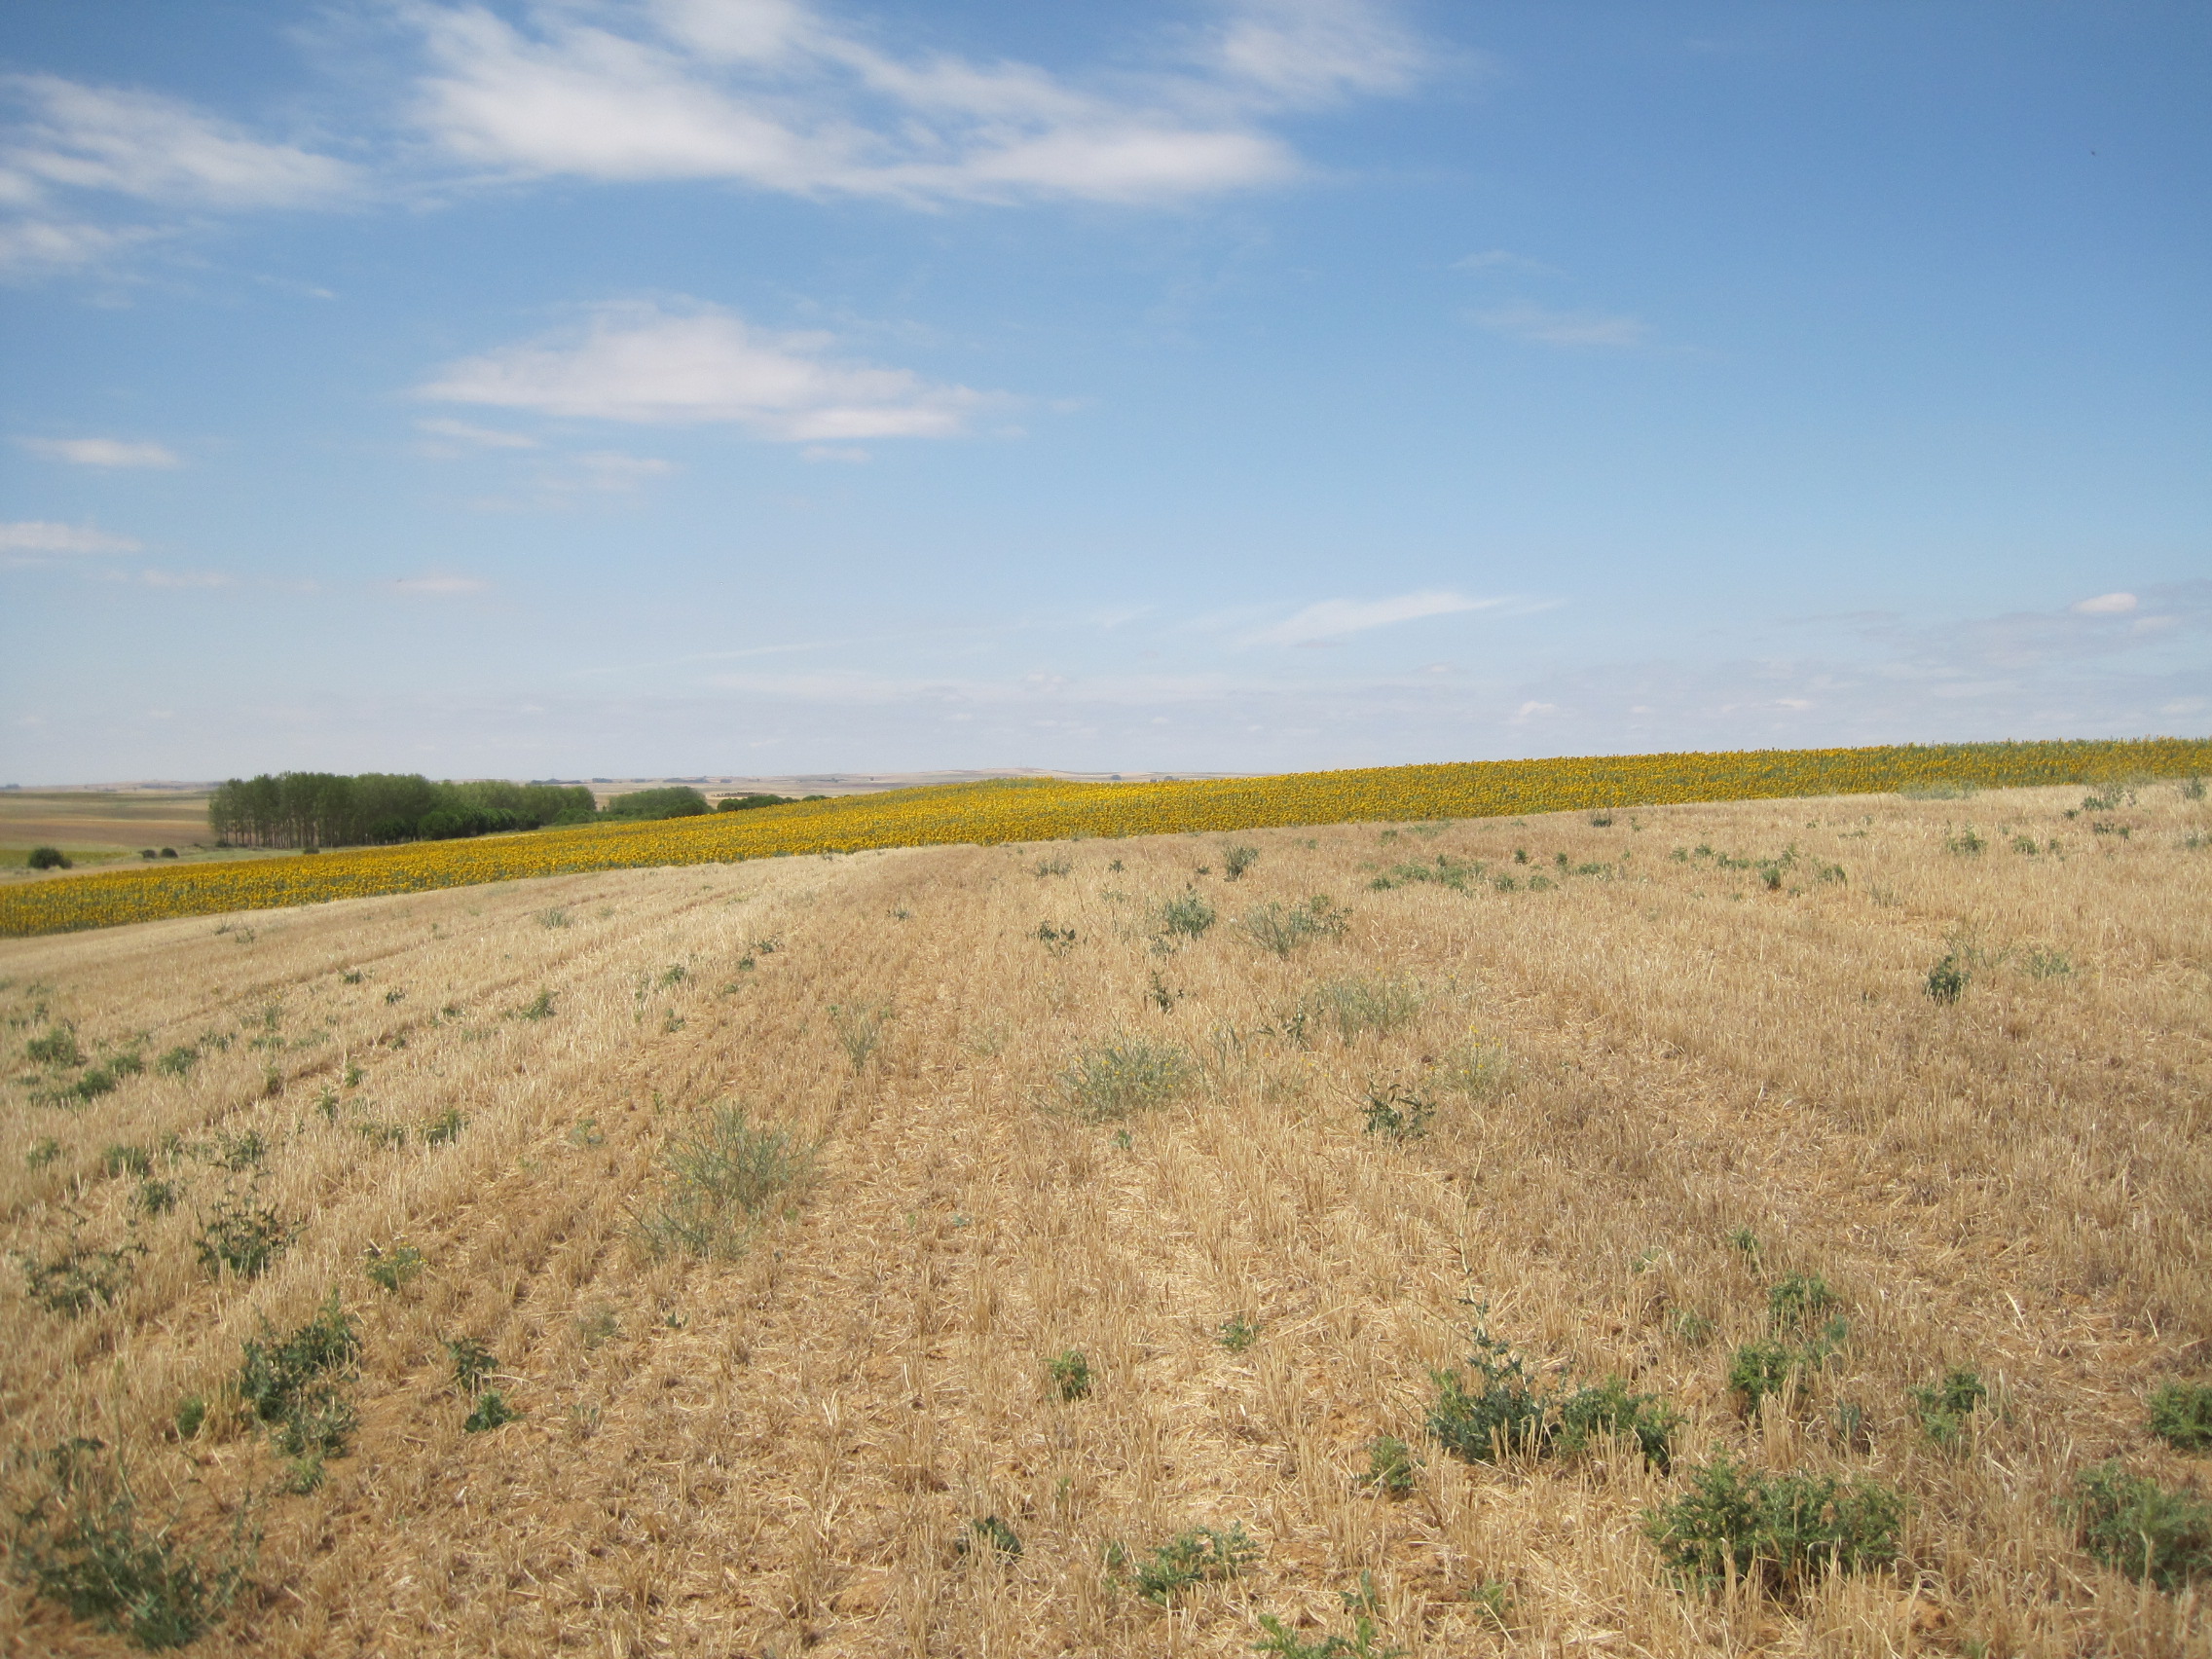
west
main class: Cropland
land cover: Barley
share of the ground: < 10 %
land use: Agriculture (excluding fallow land and kitchen gardens)
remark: Harvested field
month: July
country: ES
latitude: 42.0285
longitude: -5.2169
